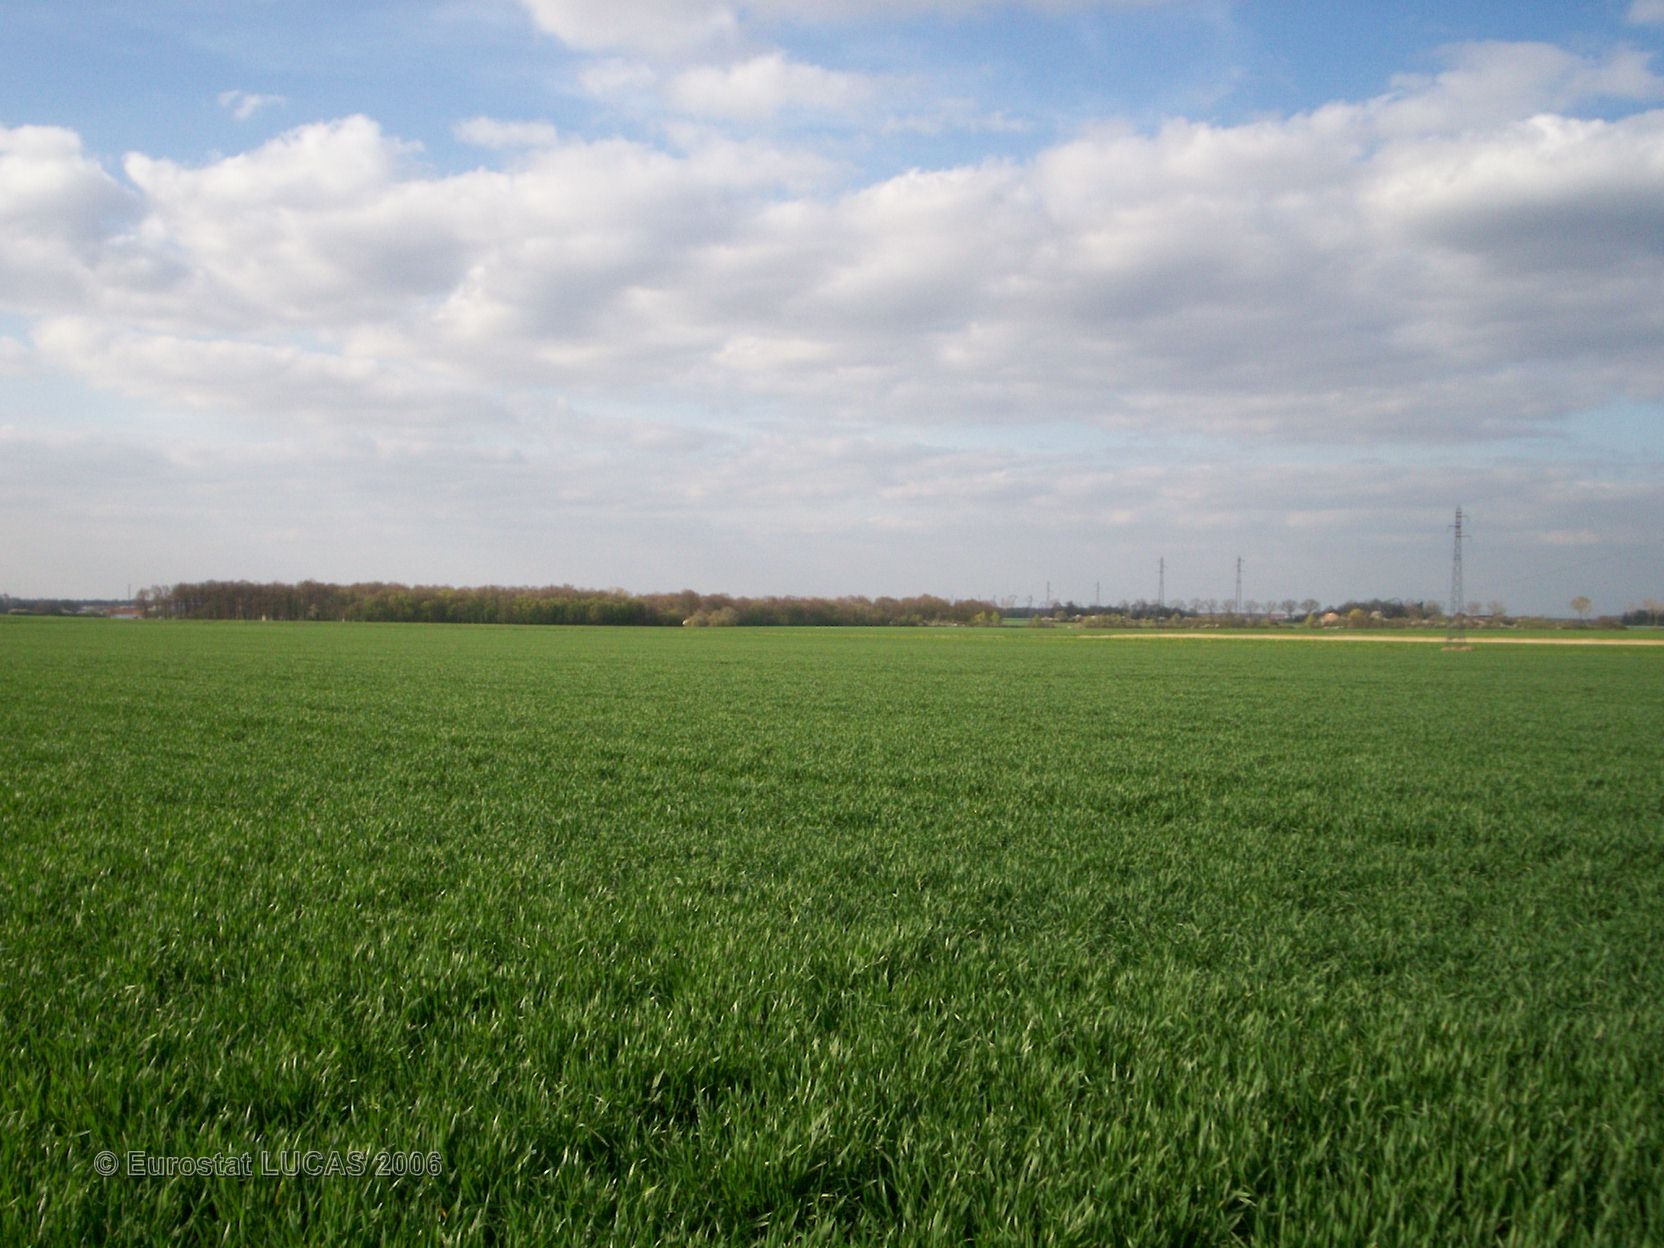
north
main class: Cropland
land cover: Common wheat
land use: Agriculture (excluding fallow land and kitchen gardens)
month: April
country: FR
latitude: 48.4762
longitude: 2.8080
